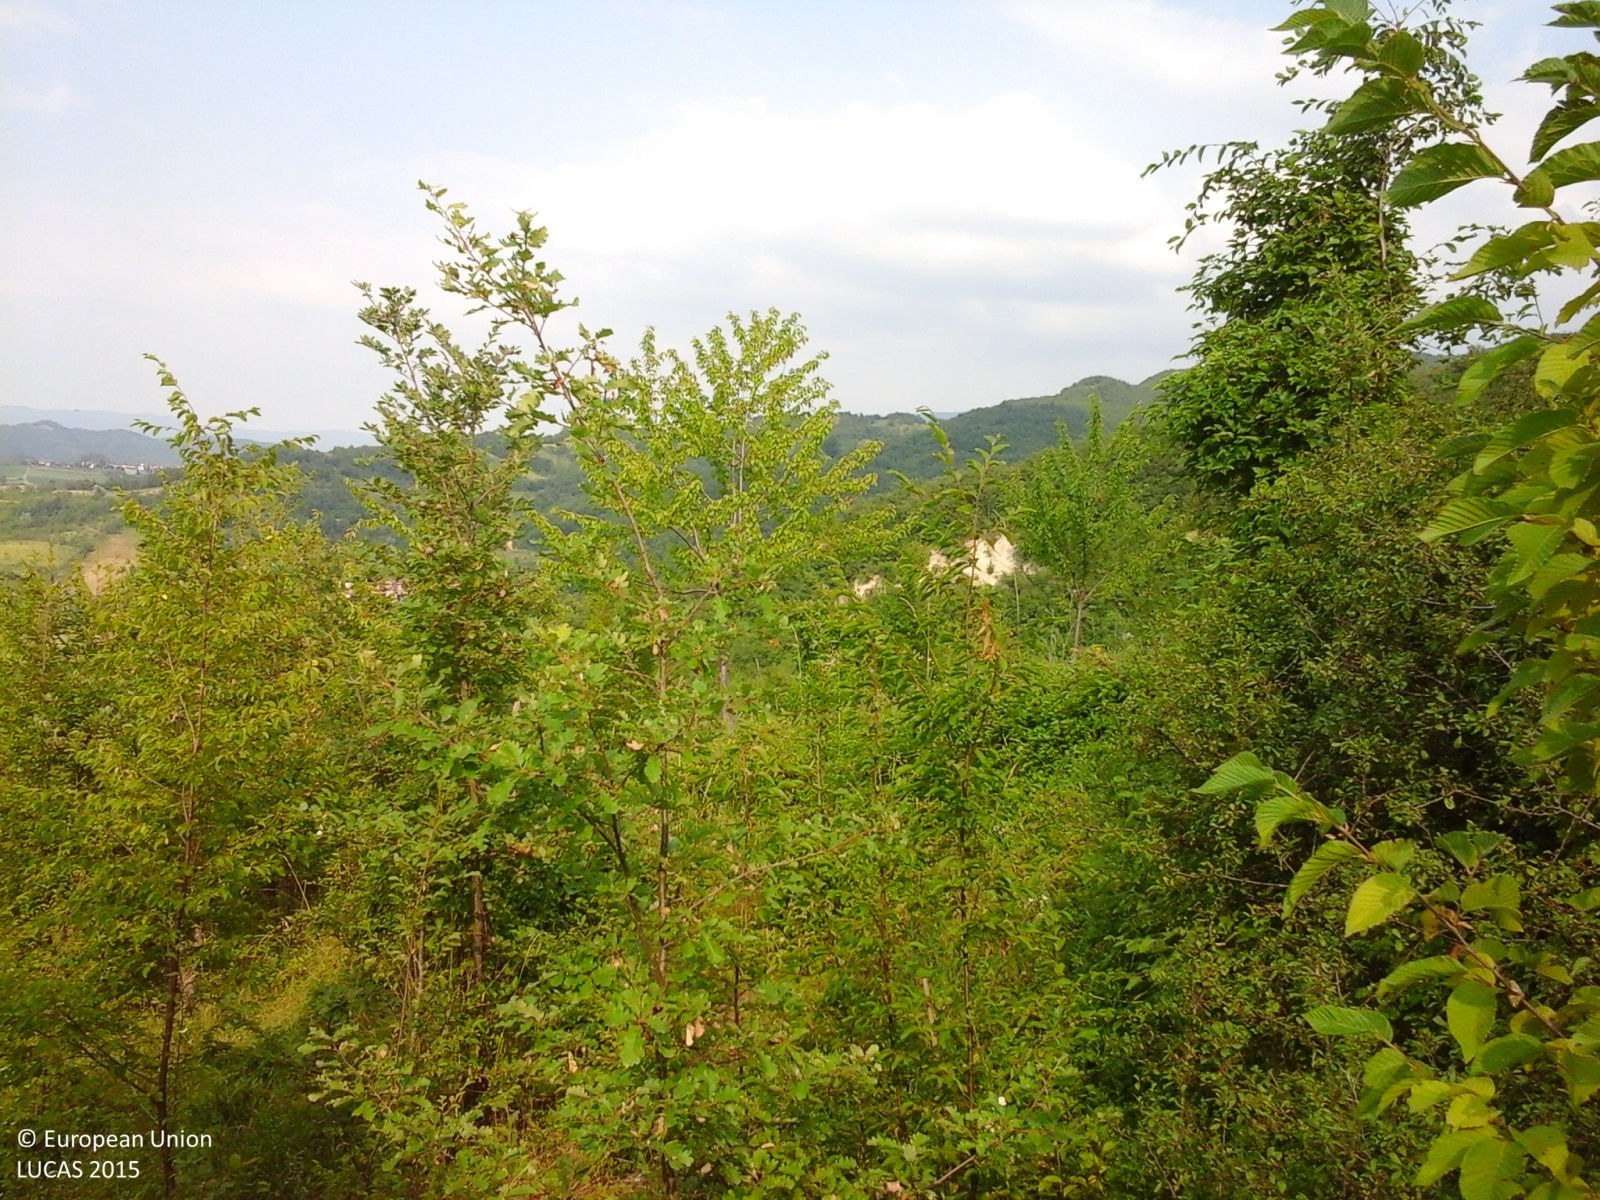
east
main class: Woodland
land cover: Broadleaved woodland
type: thermophilous deciduous forest
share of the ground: > 75 %
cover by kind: broadleaved forest trees 75 %, herbaceous plants 15 %, shrubs 10 %
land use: Agriculture (excluding fallow land and kitchen gardens)
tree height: < 5 m
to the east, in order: Broadleaved woodland
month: July
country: IT
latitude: 44.7615
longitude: 9.1049
